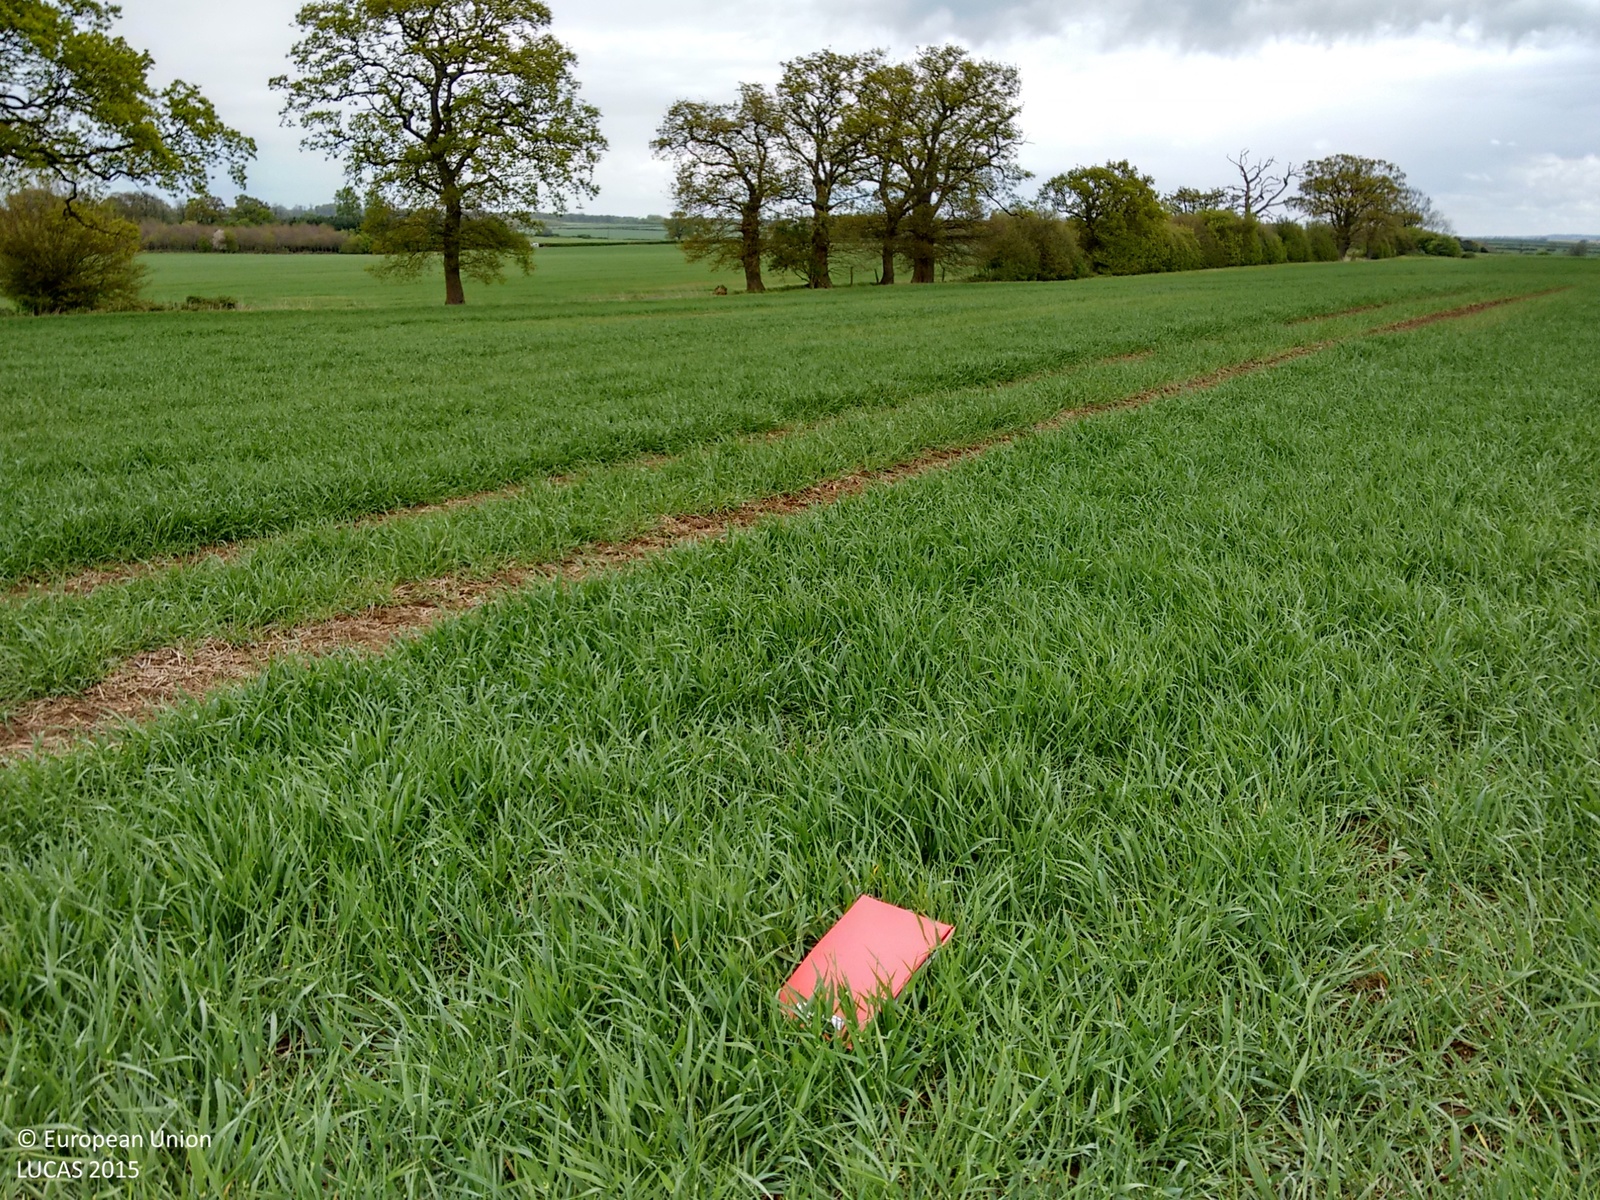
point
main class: Cropland
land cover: Barley
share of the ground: > 75 %
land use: Agriculture (excluding fallow land and kitchen gardens)
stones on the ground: 25 - 50 %
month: May
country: GB
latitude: 51.9694
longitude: -0.6513
